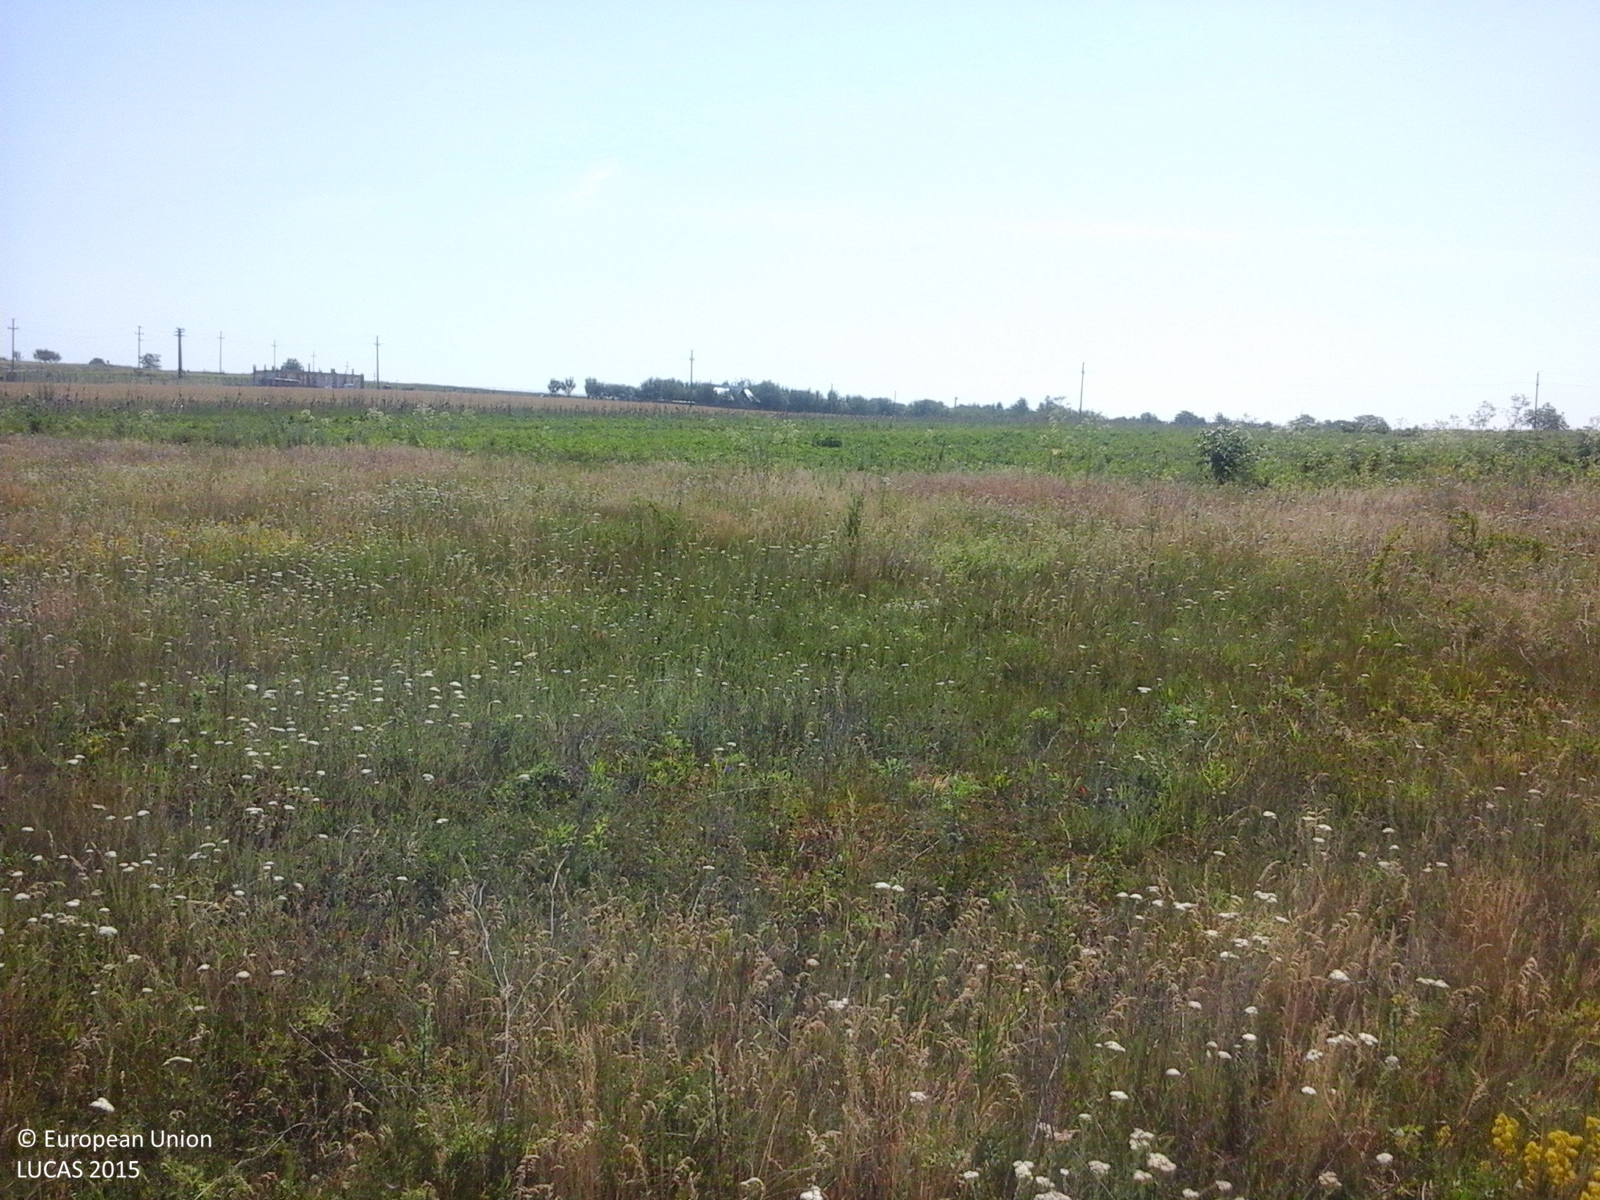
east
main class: Grassland
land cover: Grassland without tree/shrub cover
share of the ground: > 75 %
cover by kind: herbaceous plants 100 %
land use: Agriculture (excluding fallow land and kitchen gardens)
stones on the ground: < 10 %
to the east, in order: Grassland without tree/shrub cover; Tracks; Dry pulses; Spontaneously vegetated surfaces; Common wheat
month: June
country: RO
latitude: 47.1000
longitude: 27.5211
